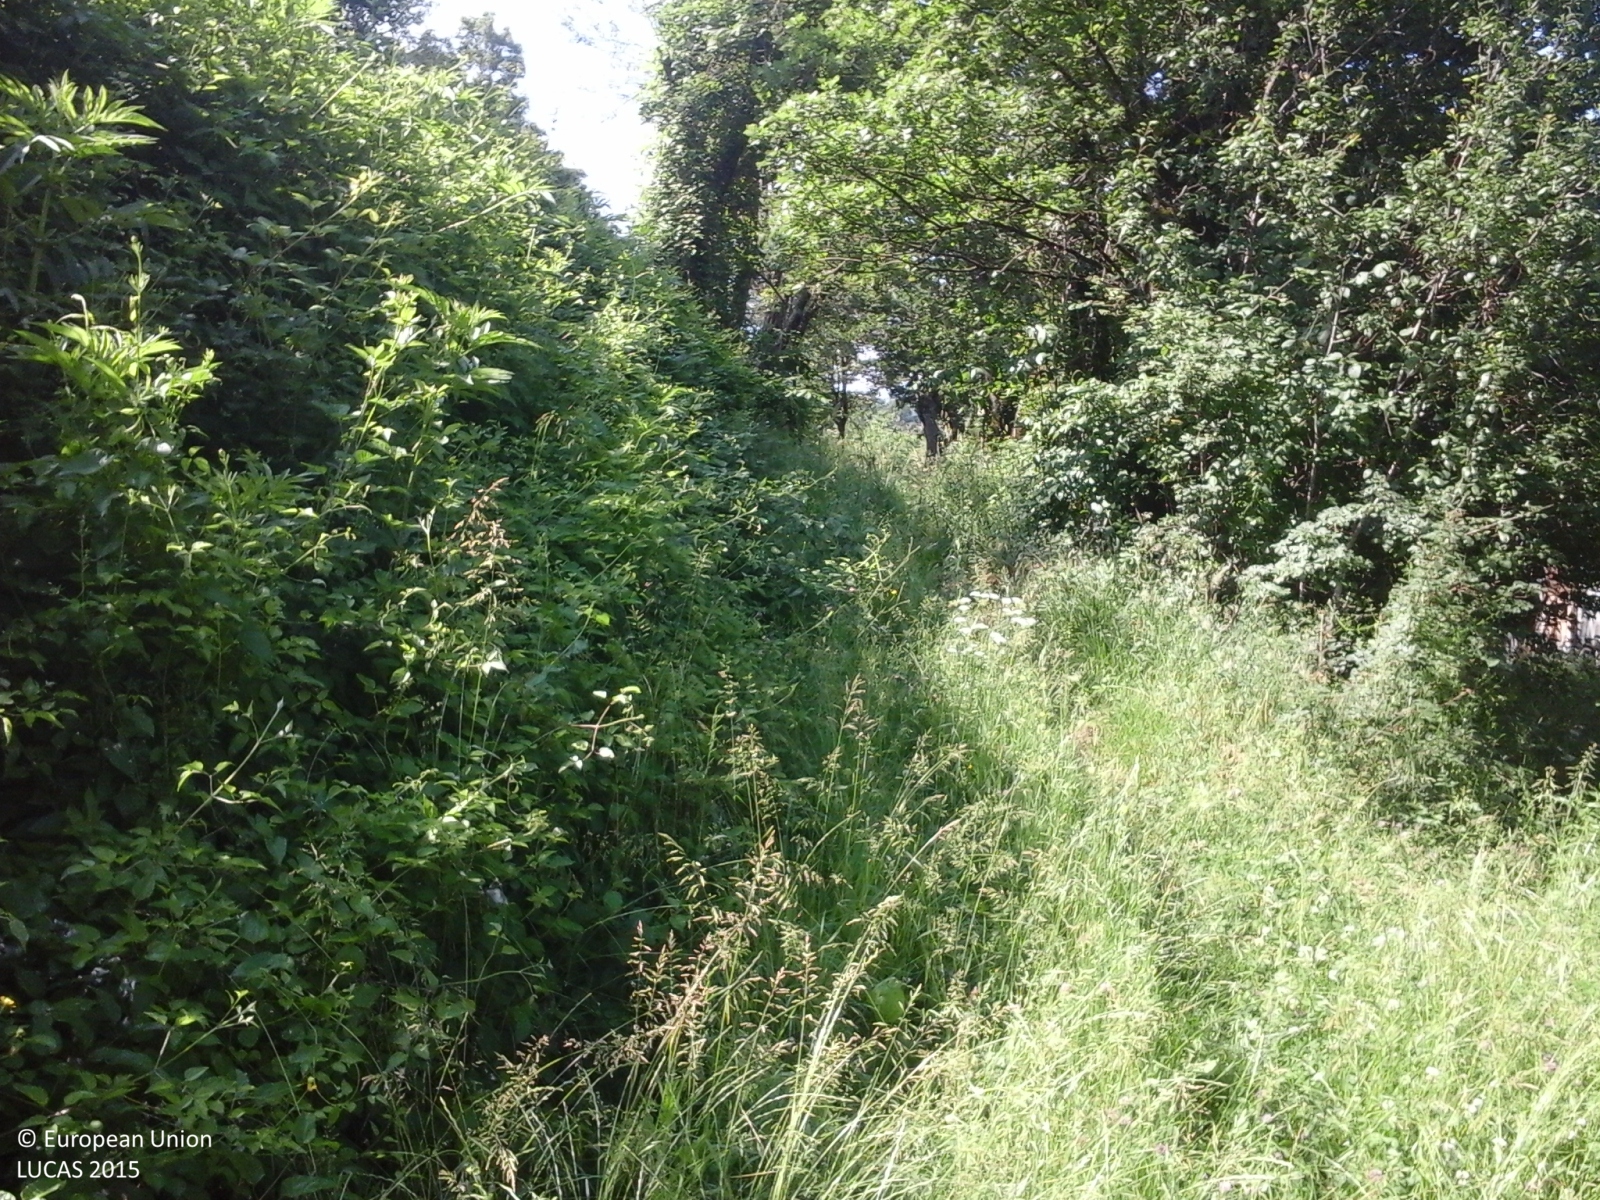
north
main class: Grassland
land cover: Grassland without tree/shrub cover
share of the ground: > 75 %
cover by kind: herbaceous plants 100 %
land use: Semi-natural and natural areas not in use
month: June
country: IT
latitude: 44.3306
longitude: 10.6381
